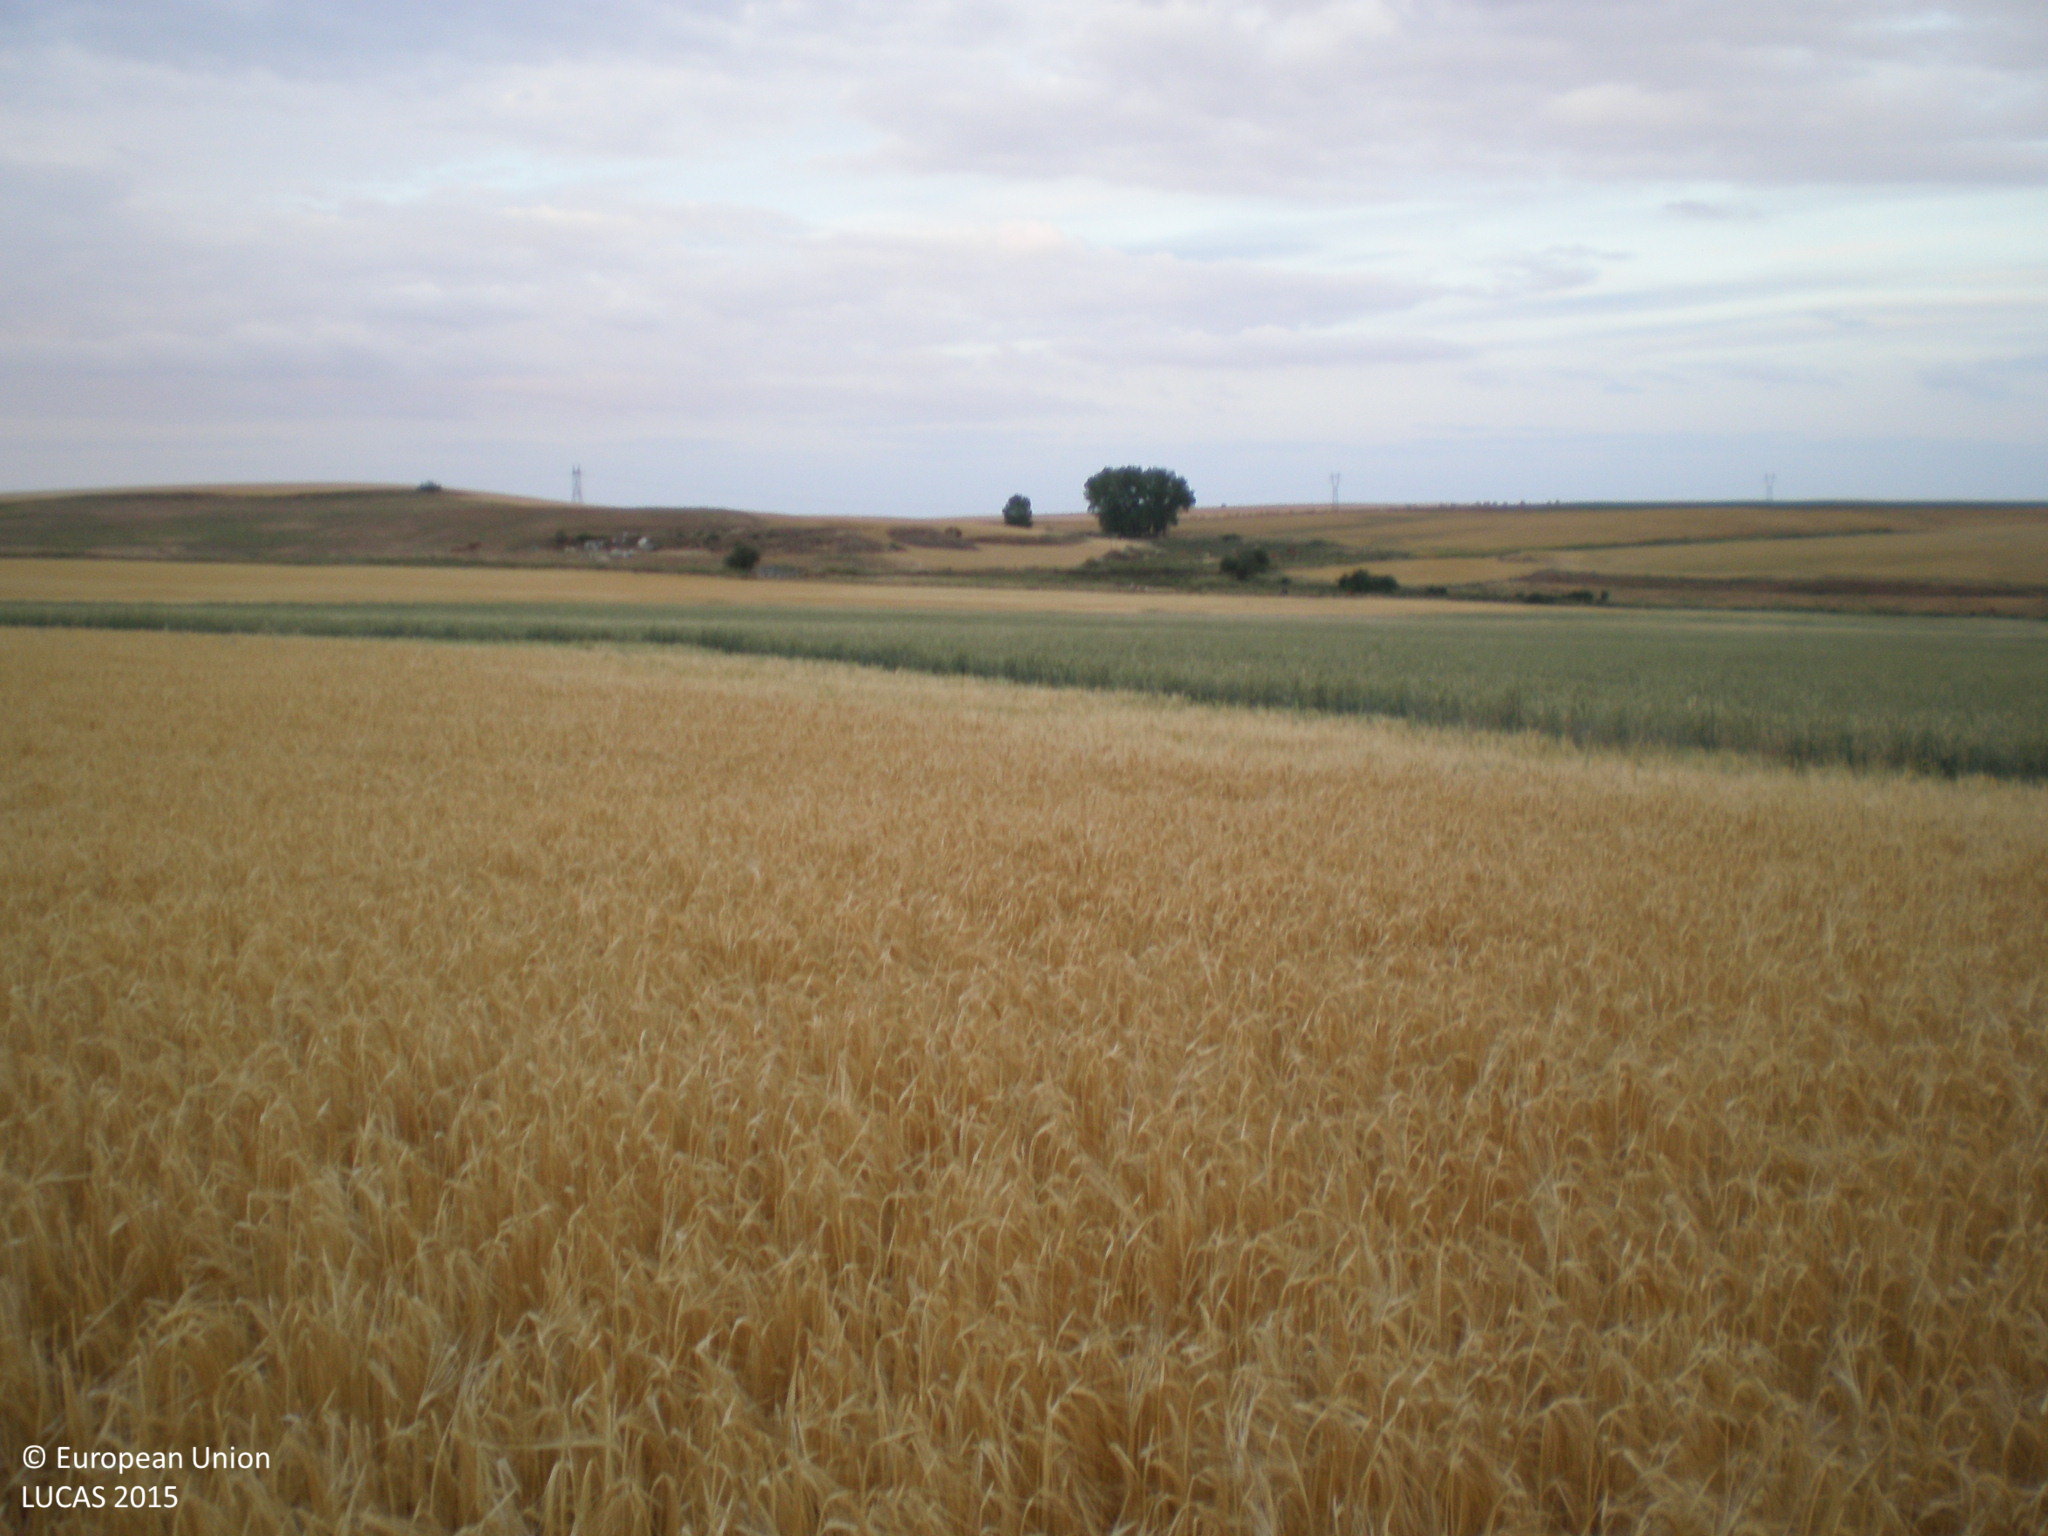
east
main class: Cropland
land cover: Barley
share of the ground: > 75 %
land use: Agriculture (excluding fallow land and kitchen gardens)
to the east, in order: Barley; Rye
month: June
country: ES
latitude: 41.0596
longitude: -5.7759
